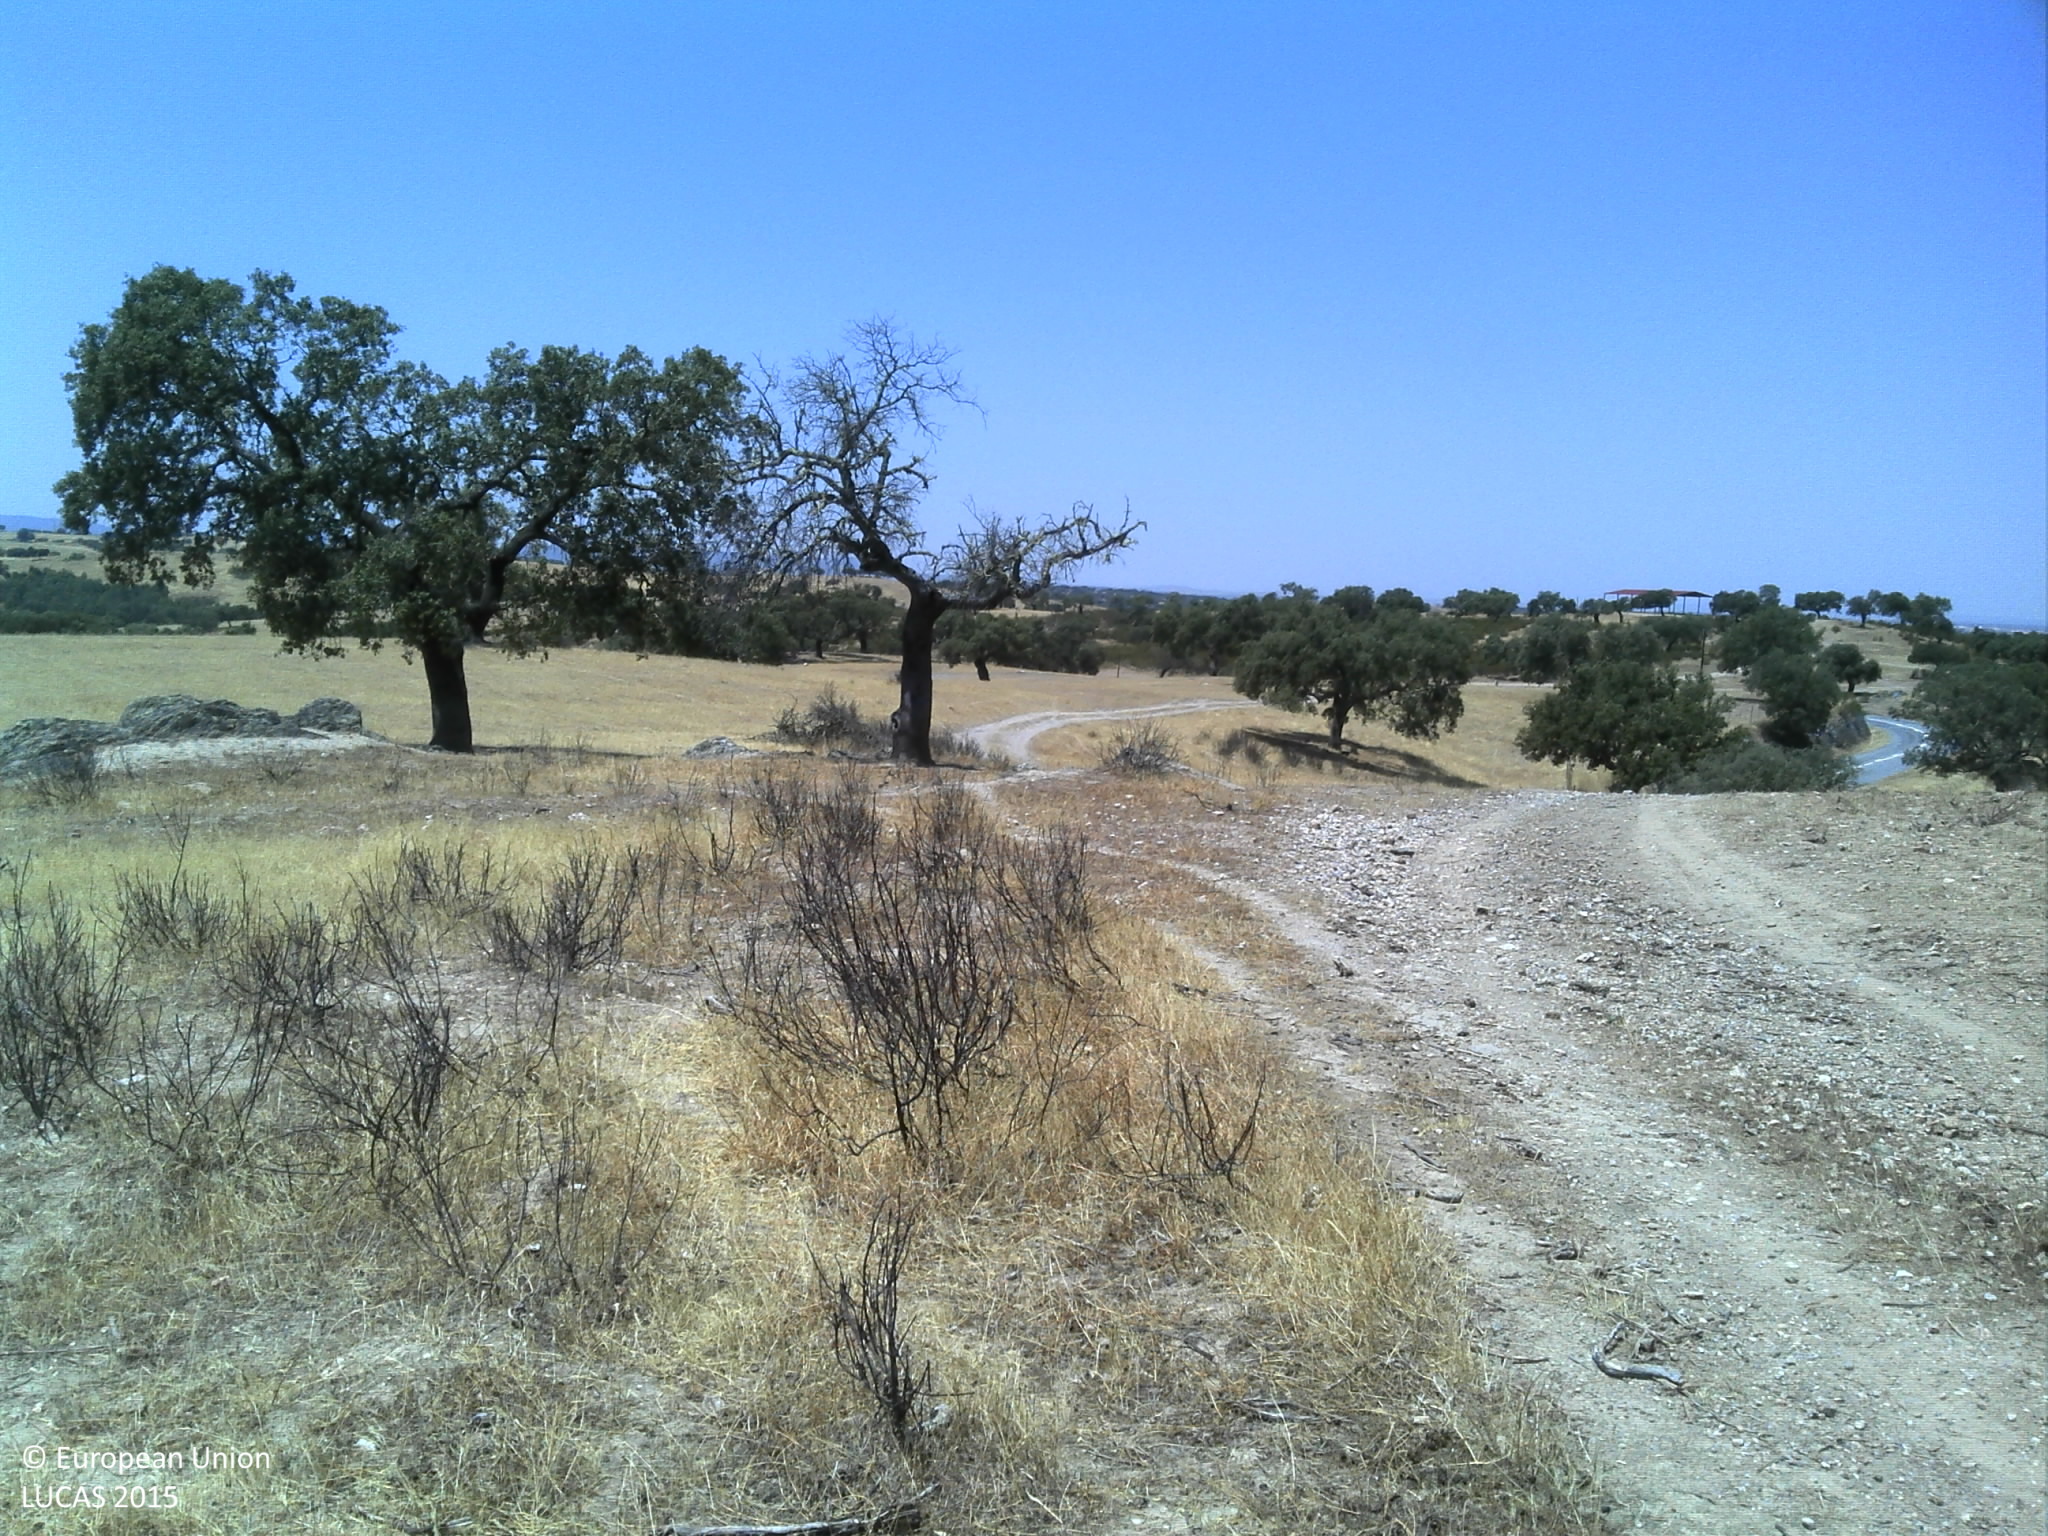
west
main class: Woodland
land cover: Broadleaved woodland
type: broadleaved evergreen forest
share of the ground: 10 - 25 %
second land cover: Grassland without tree/shrub cover
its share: 10 - 25 %
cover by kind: herbaceous plants 65 %, unconsolidated bare surface 25 %, broadleaved forest trees 10 %
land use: Forestry
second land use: Agriculture (excluding fallow land and kitchen gardens)
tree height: < 5 m
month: June
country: PT
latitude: 38.0804
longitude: -7.1479
